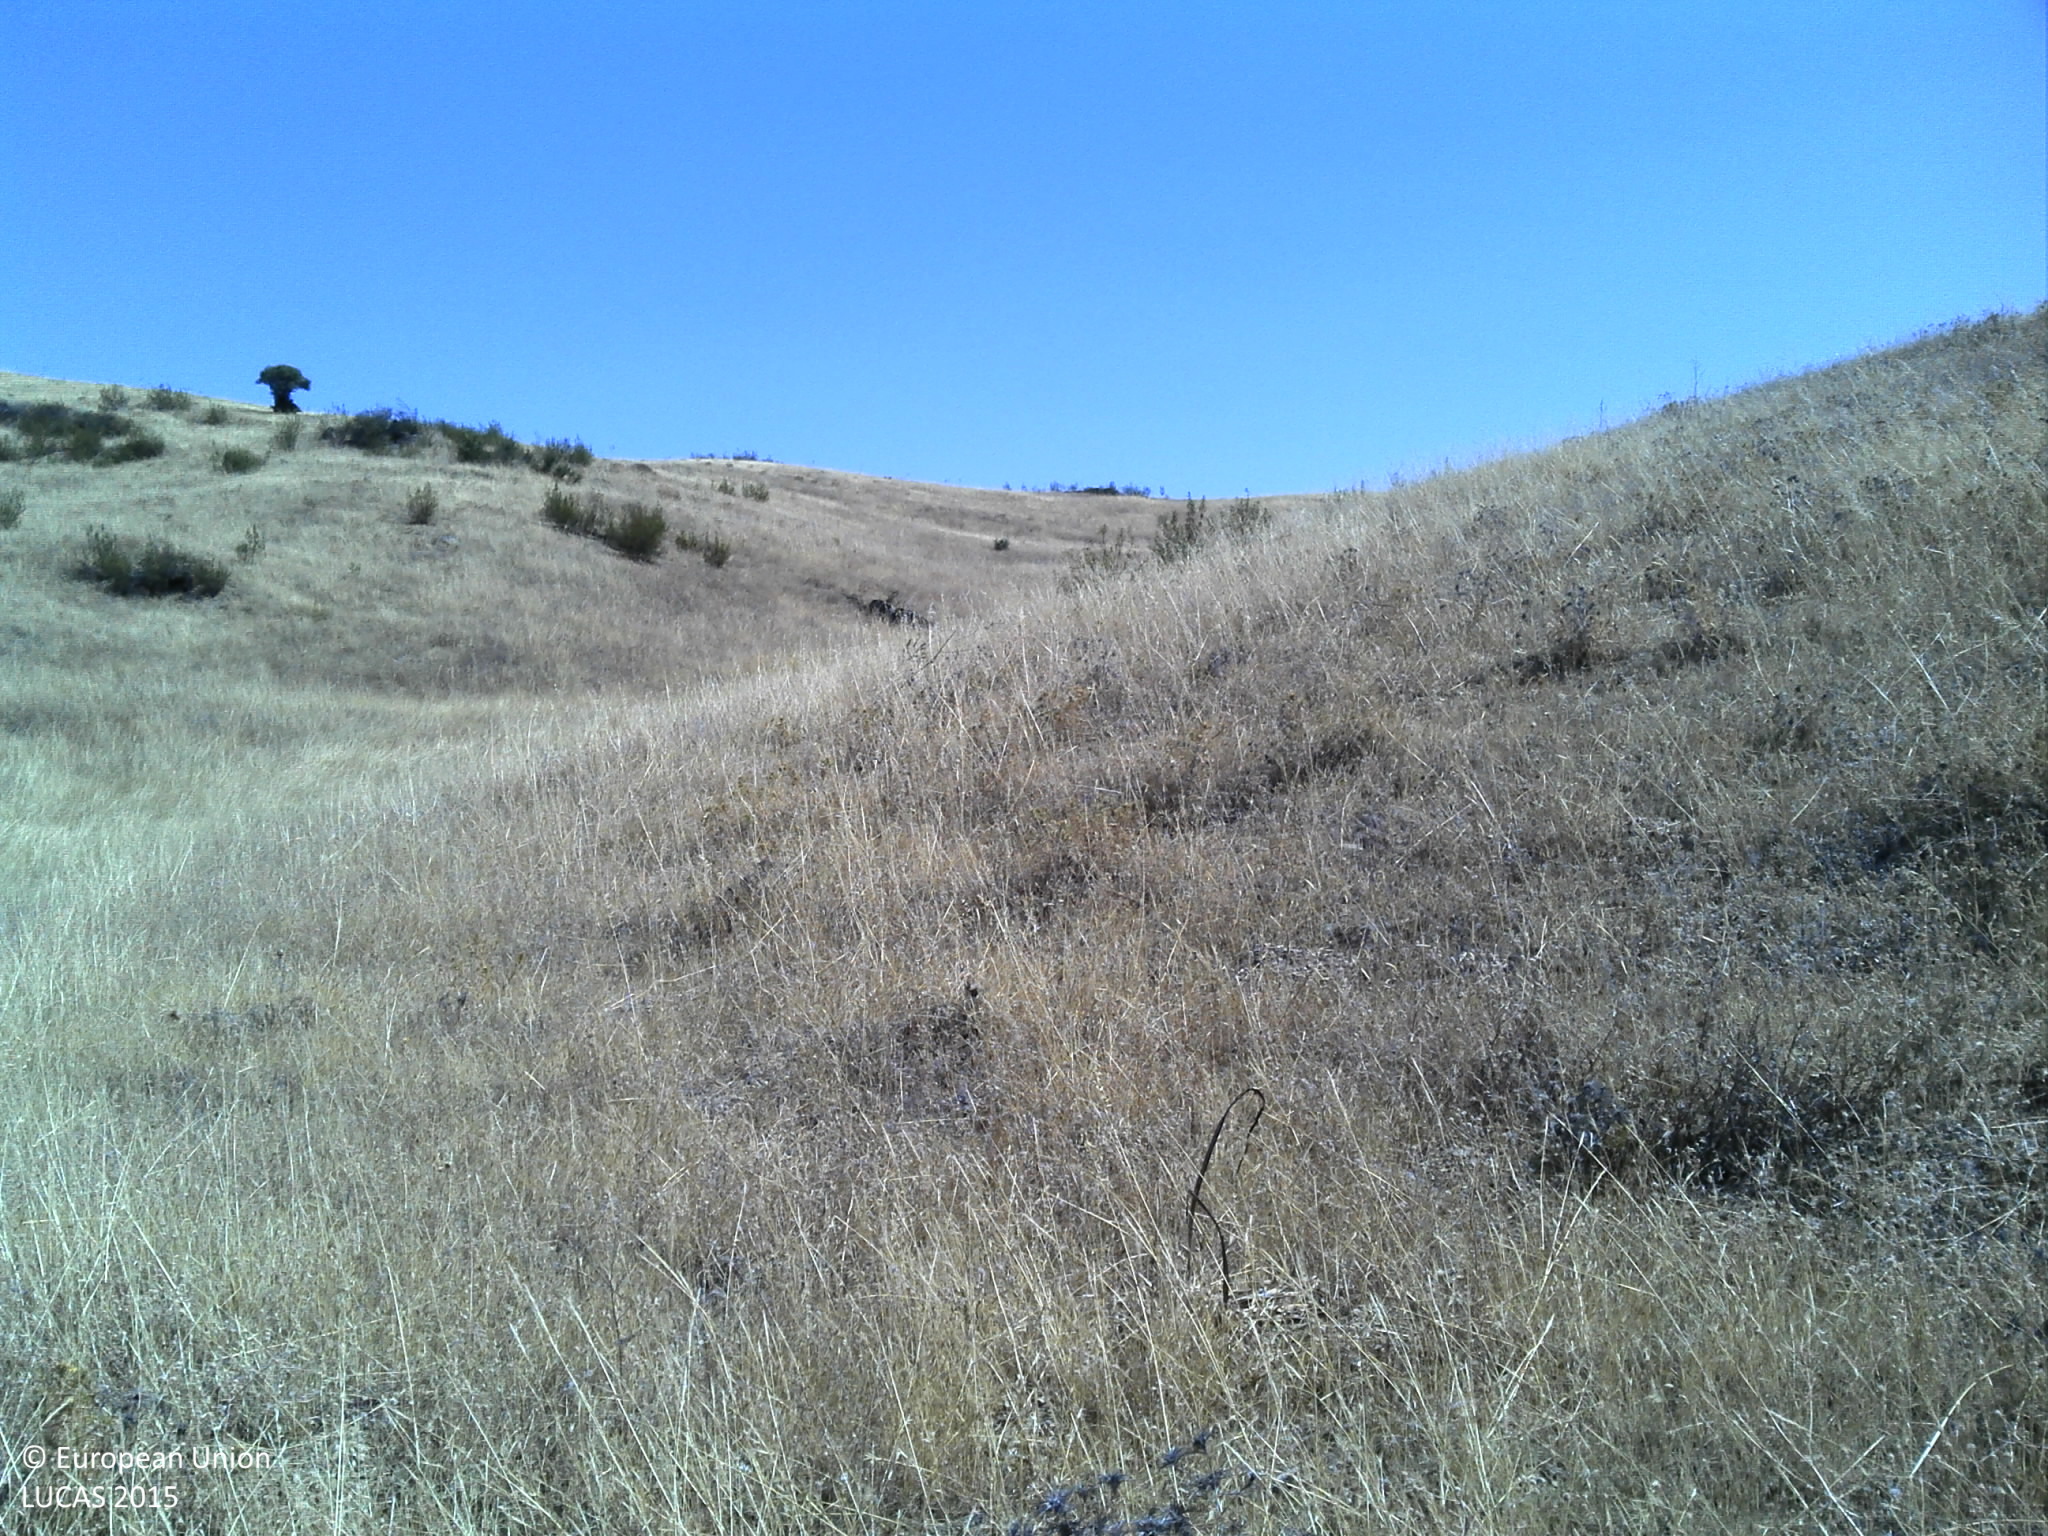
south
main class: Grassland
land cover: Grassland without tree/shrub cover
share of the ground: > 75 %
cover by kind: herbaceous plants 90 %, unconsolidated bare surface 10 %
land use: Agriculture (excluding fallow land and kitchen gardens)
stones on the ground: < 10 %
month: July
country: PT
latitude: 37.5567
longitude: -7.7777
